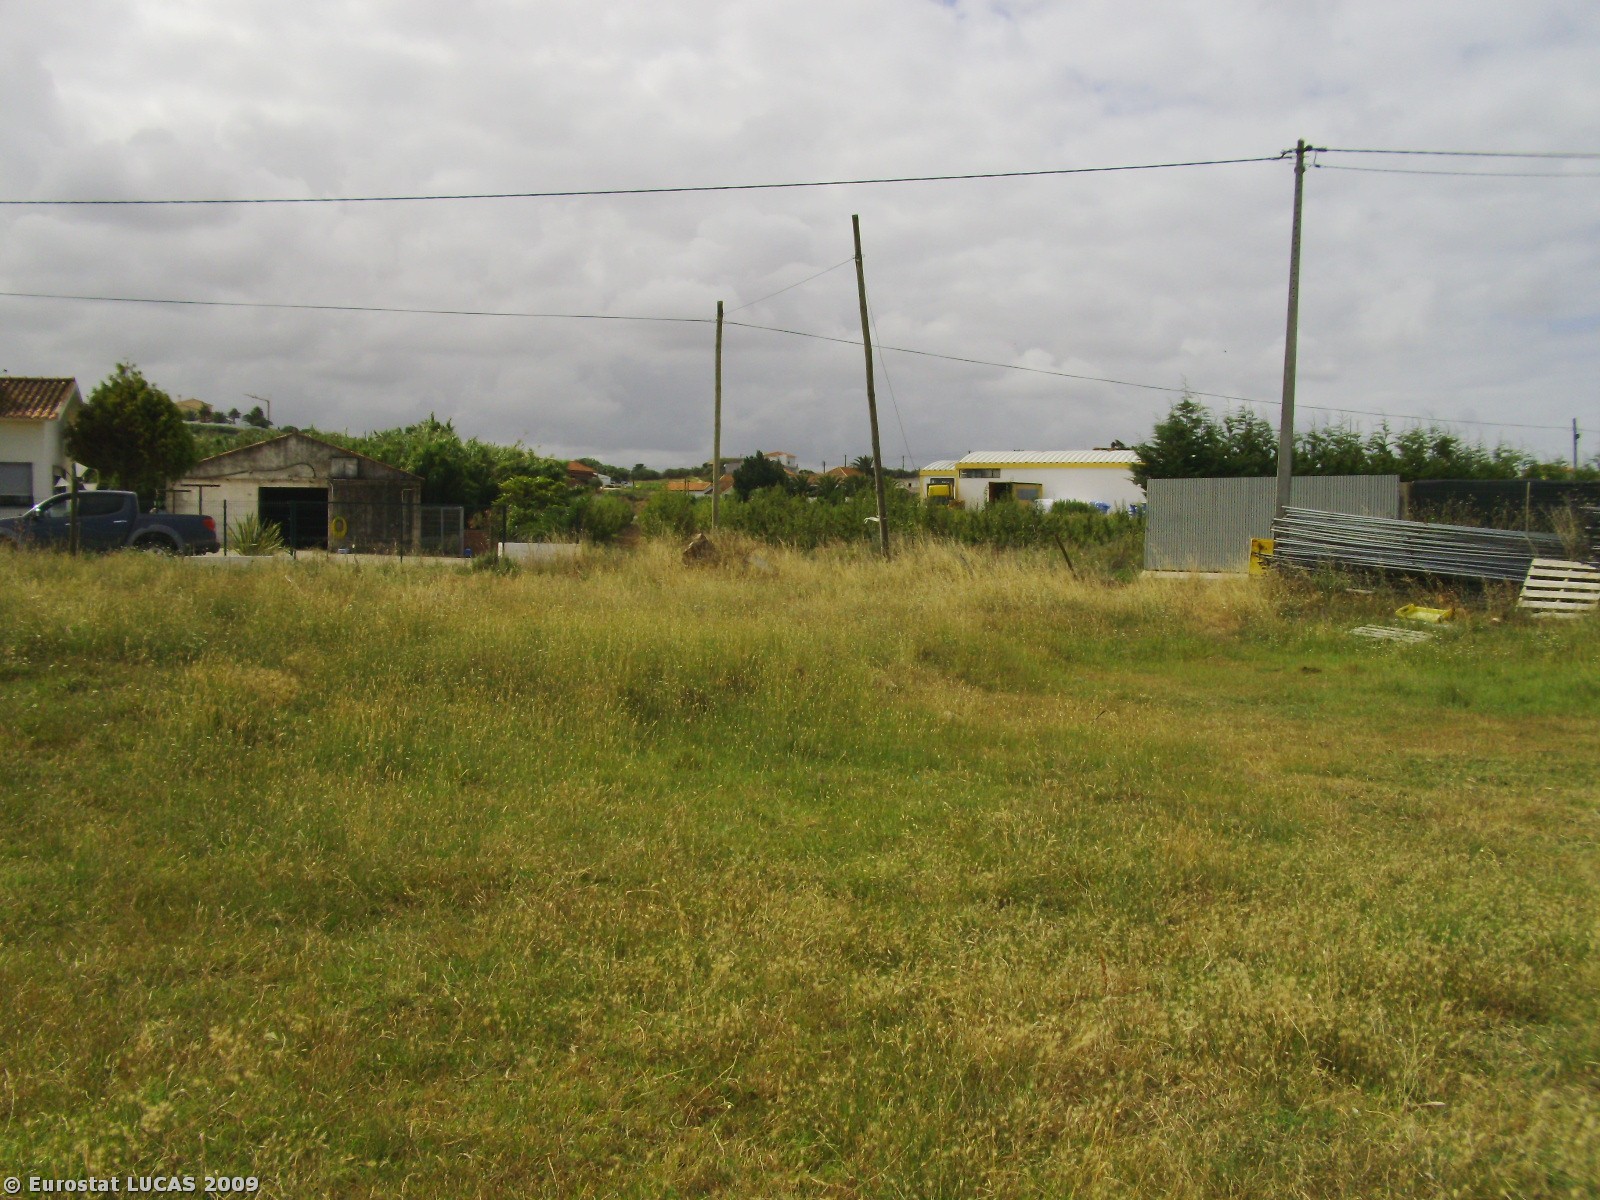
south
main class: Grassland
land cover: Spontaneously vegetated surfaces
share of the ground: > 75 %
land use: Fallow land
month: July
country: PT
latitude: 39.0831
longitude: -9.3362
